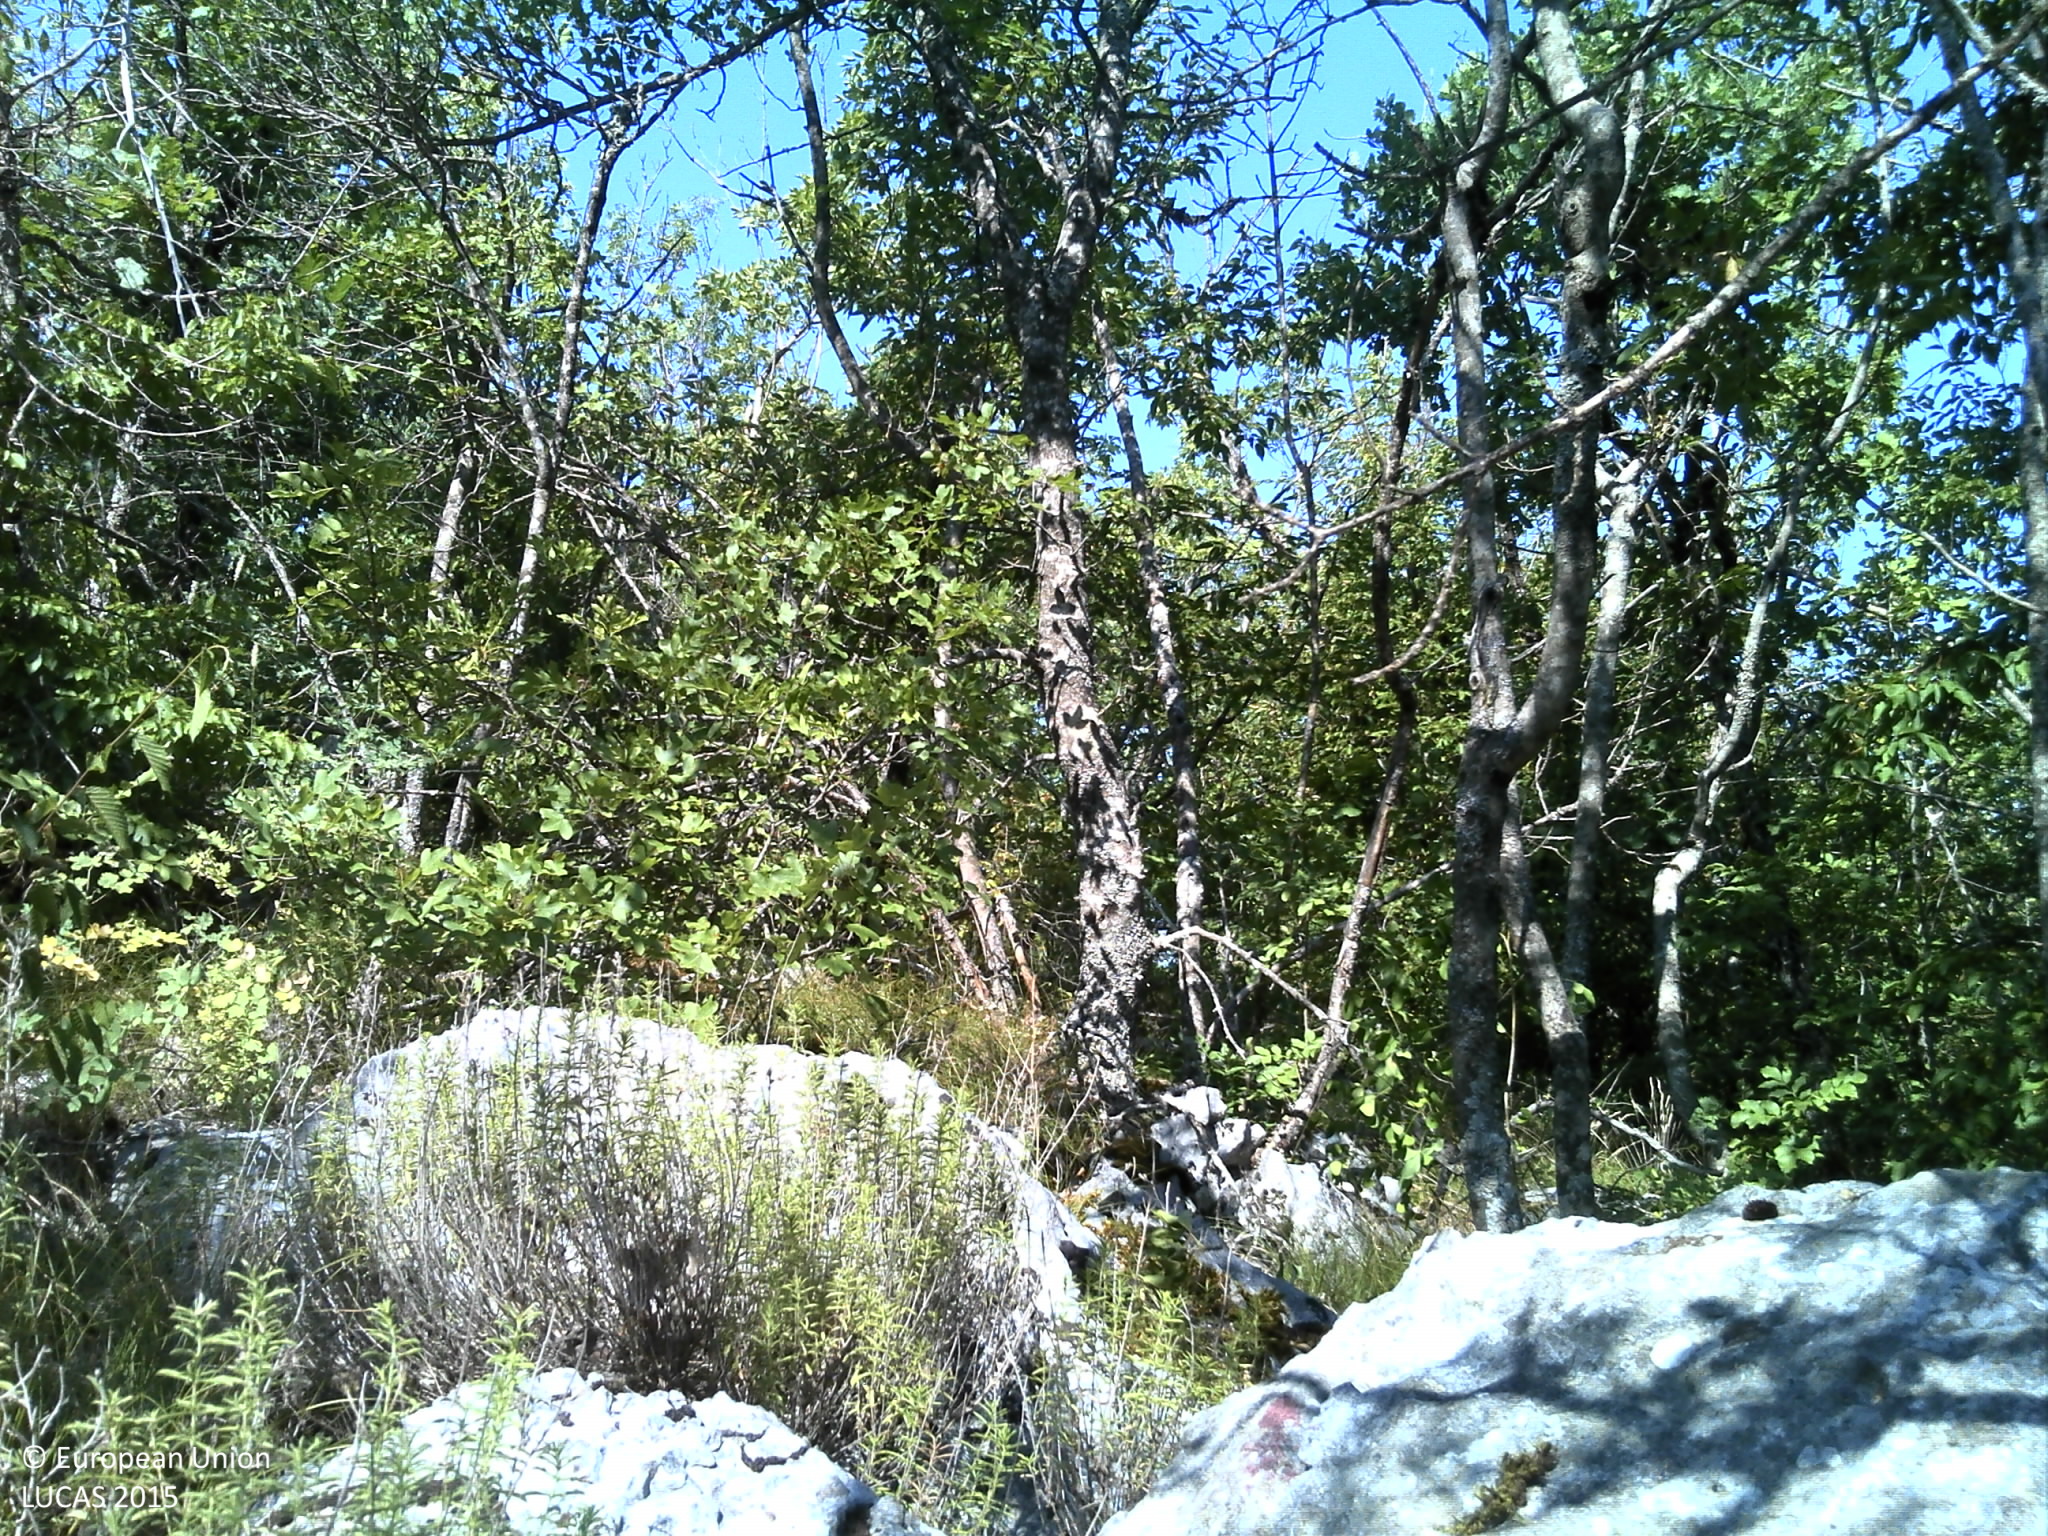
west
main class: Woodland
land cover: Broadleaved woodland
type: thermophilous deciduous forest
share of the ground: 50 - 75 %
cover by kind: broadleaved forest trees 65 %, shrubs 15 %, herbaceous plants 15 %, consolidated bare surface 5 %
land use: Semi-natural and natural areas not in use
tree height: > 5 m
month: July
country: HR
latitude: 43.4017
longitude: 17.0912
